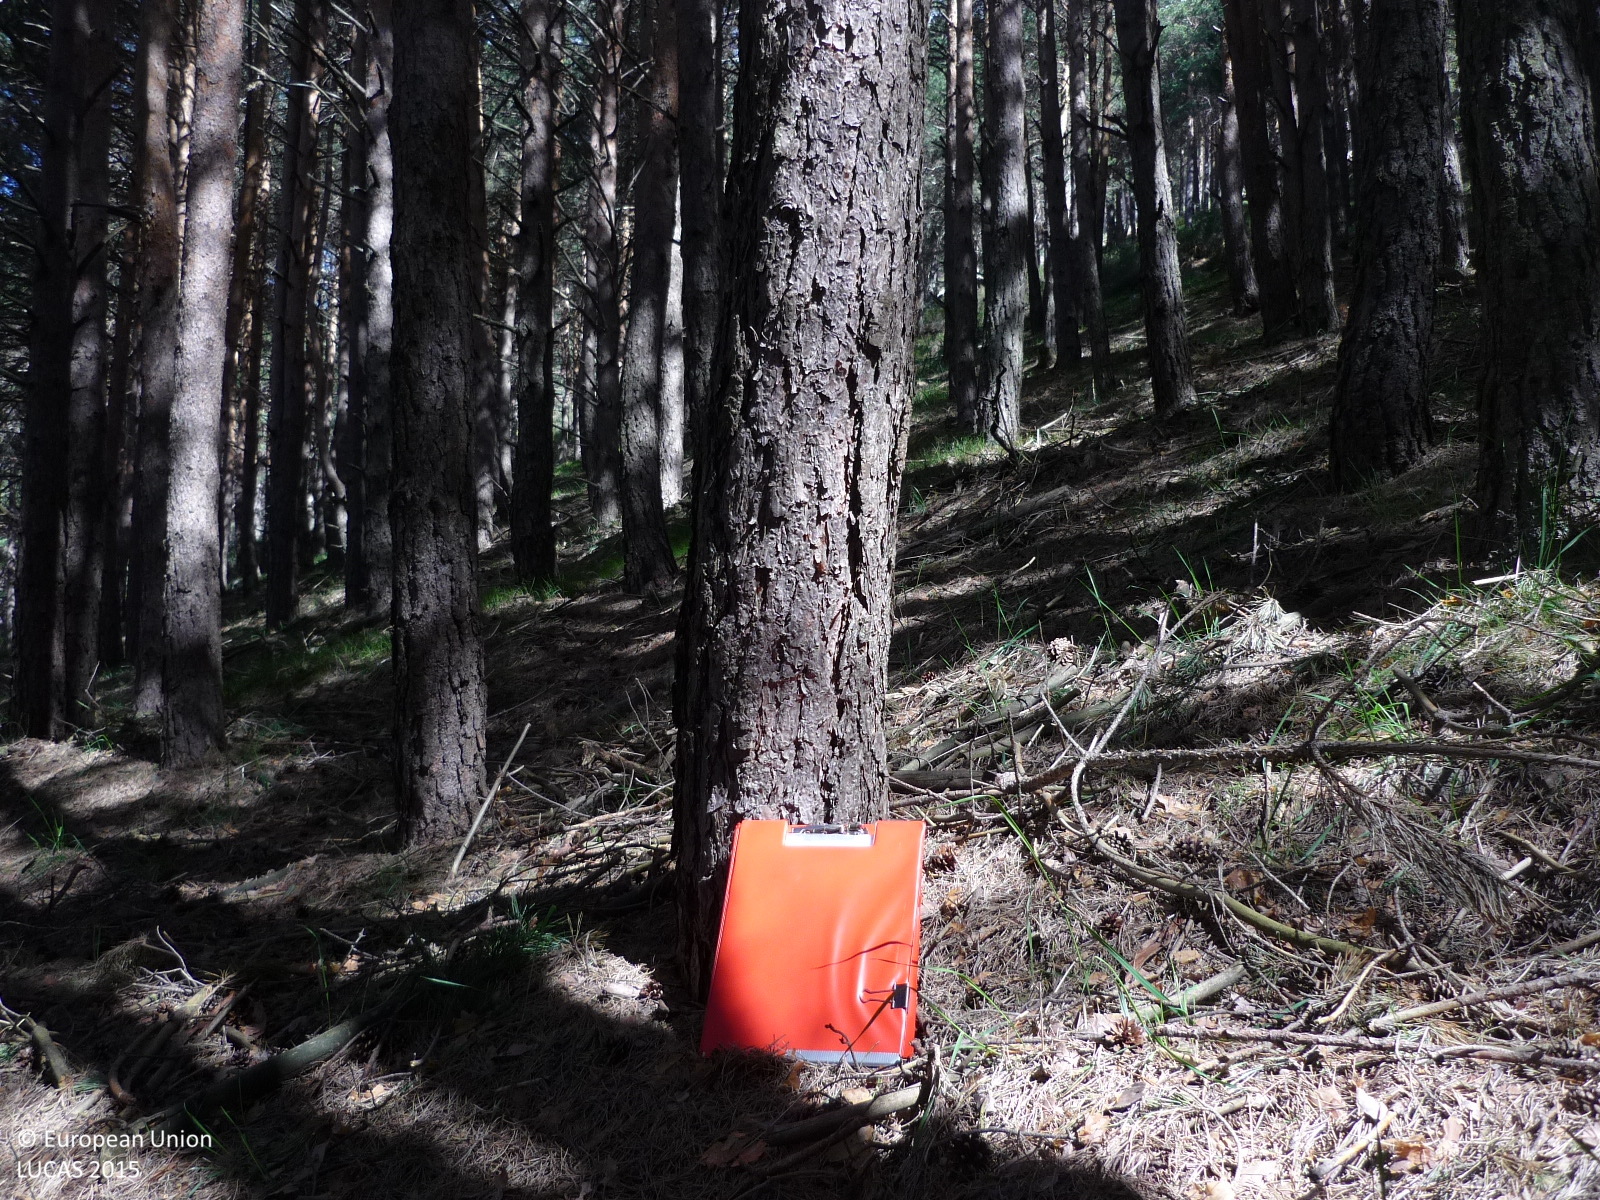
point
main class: Woodland
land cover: Pine dominated coniferous woodland
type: coniferous forest of the mediterranean region
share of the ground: > 75 %
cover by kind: coniferous forest trees 85 %, shrubs 10 %, herbaceous plants 5 %
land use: Forestry
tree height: > 5 m
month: May
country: ES
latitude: 41.0570
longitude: -3.7175
